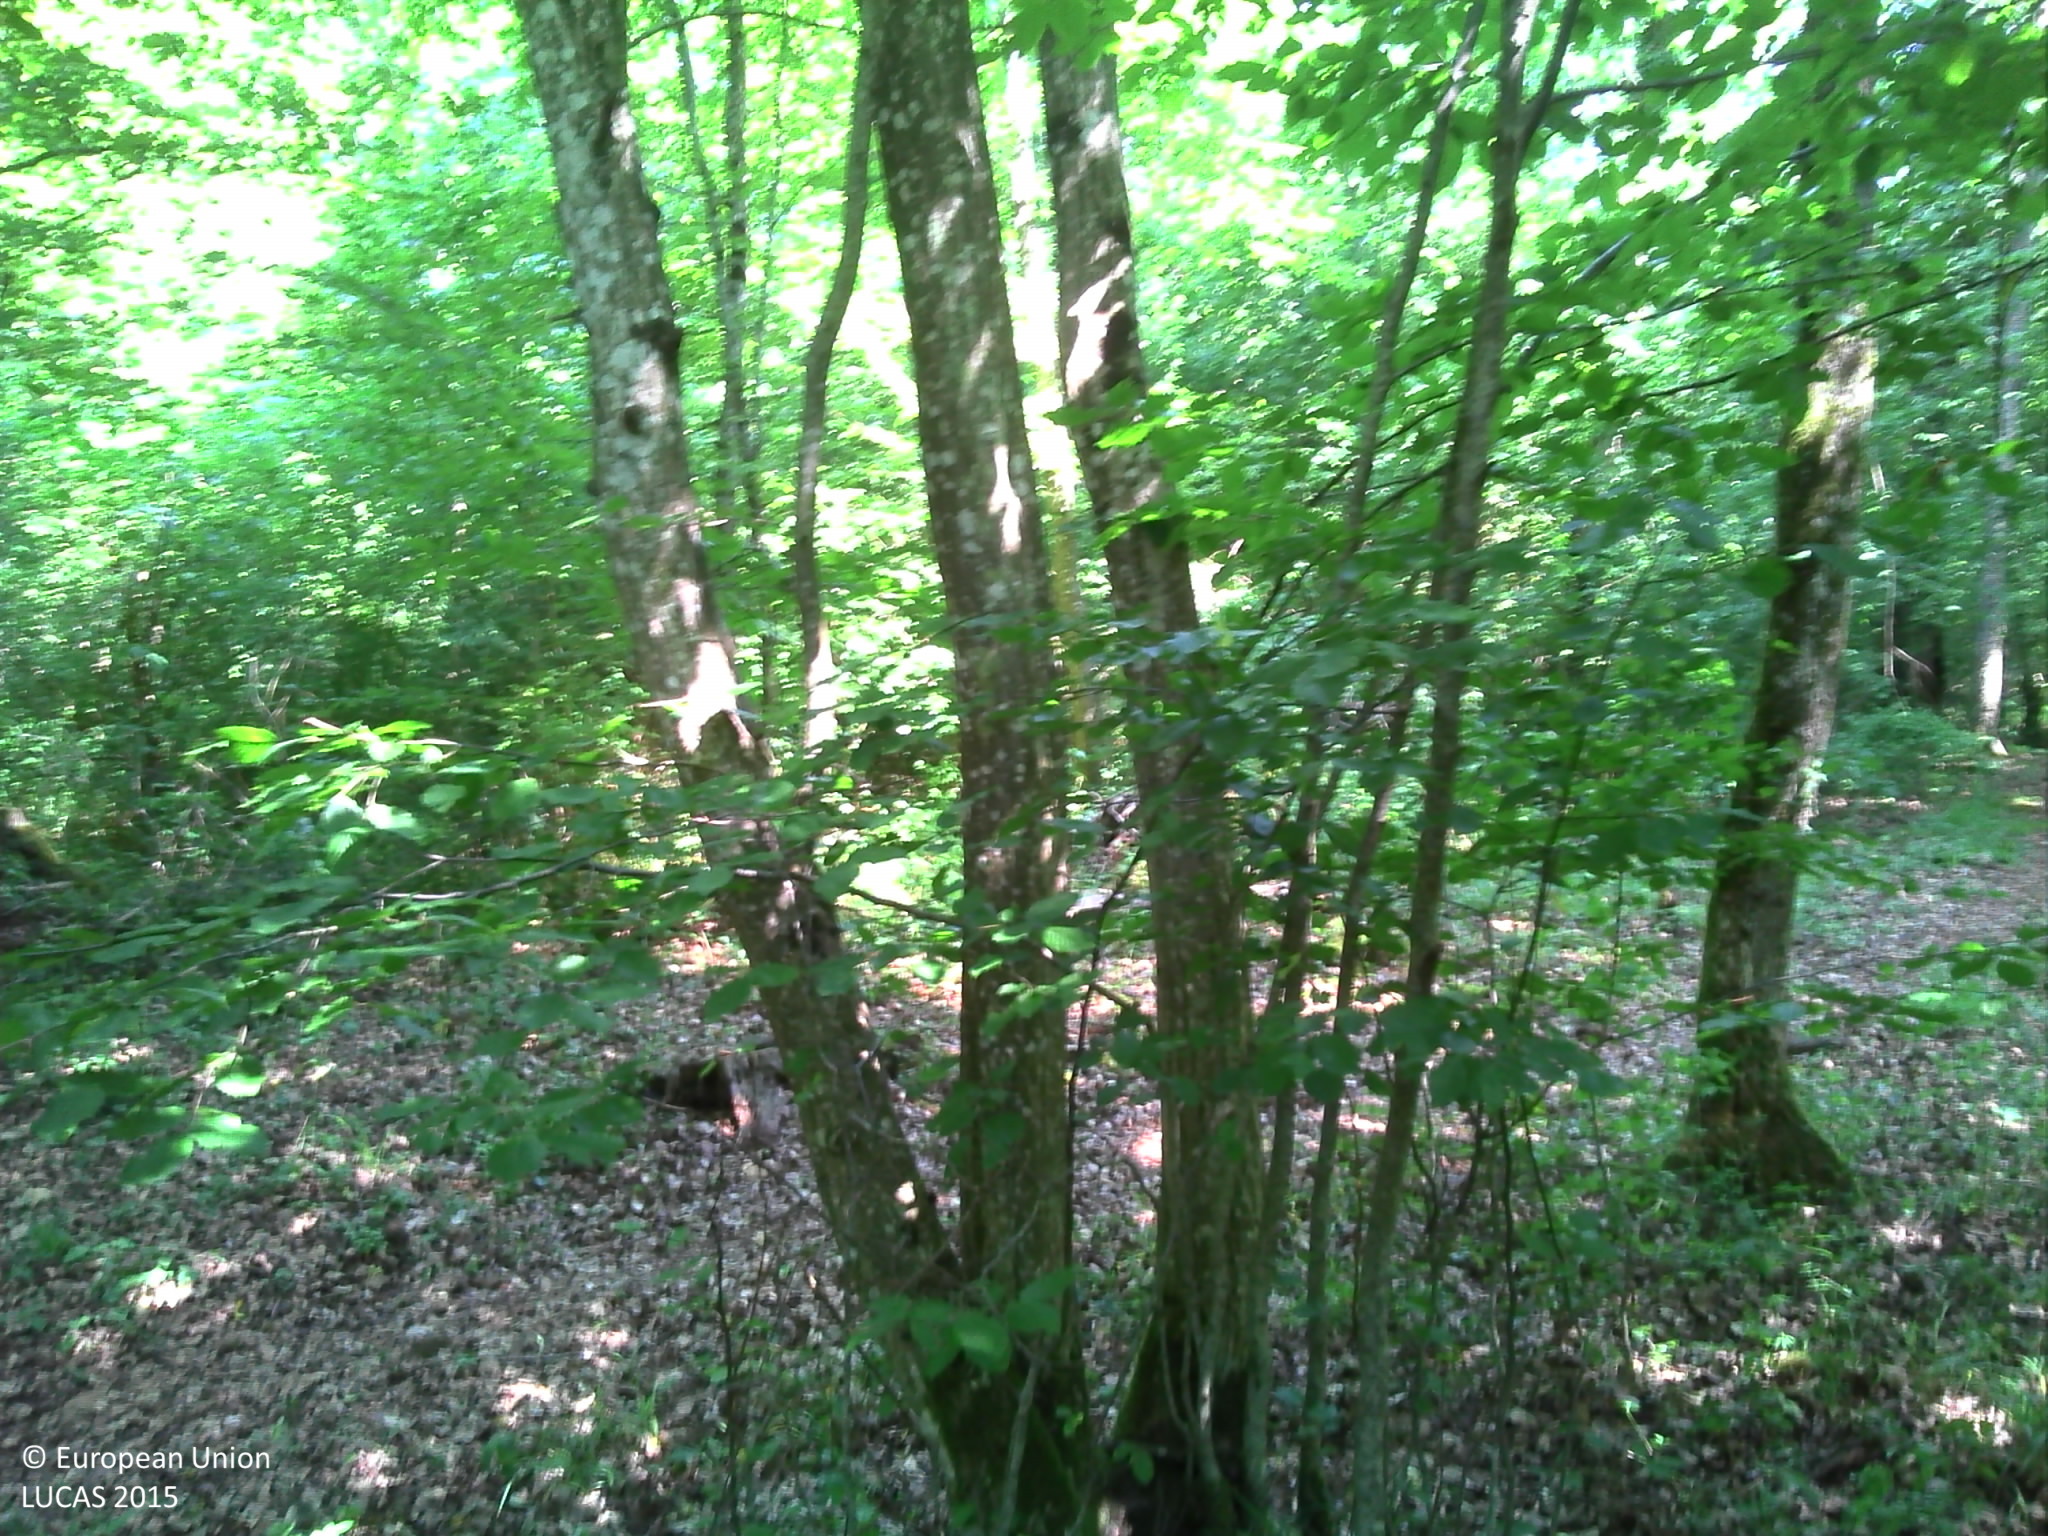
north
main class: Woodland
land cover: Broadleaved woodland
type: mesophytic deciduous forest
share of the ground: > 75 %
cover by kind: broadleaved forest trees 90 %, herbaceous plants 5 %, lichens and mosses 5 %
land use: Forestry
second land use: Amenities, museums, leisure
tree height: > 5 m
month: July
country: FR
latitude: 48.6392
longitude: 6.0508
